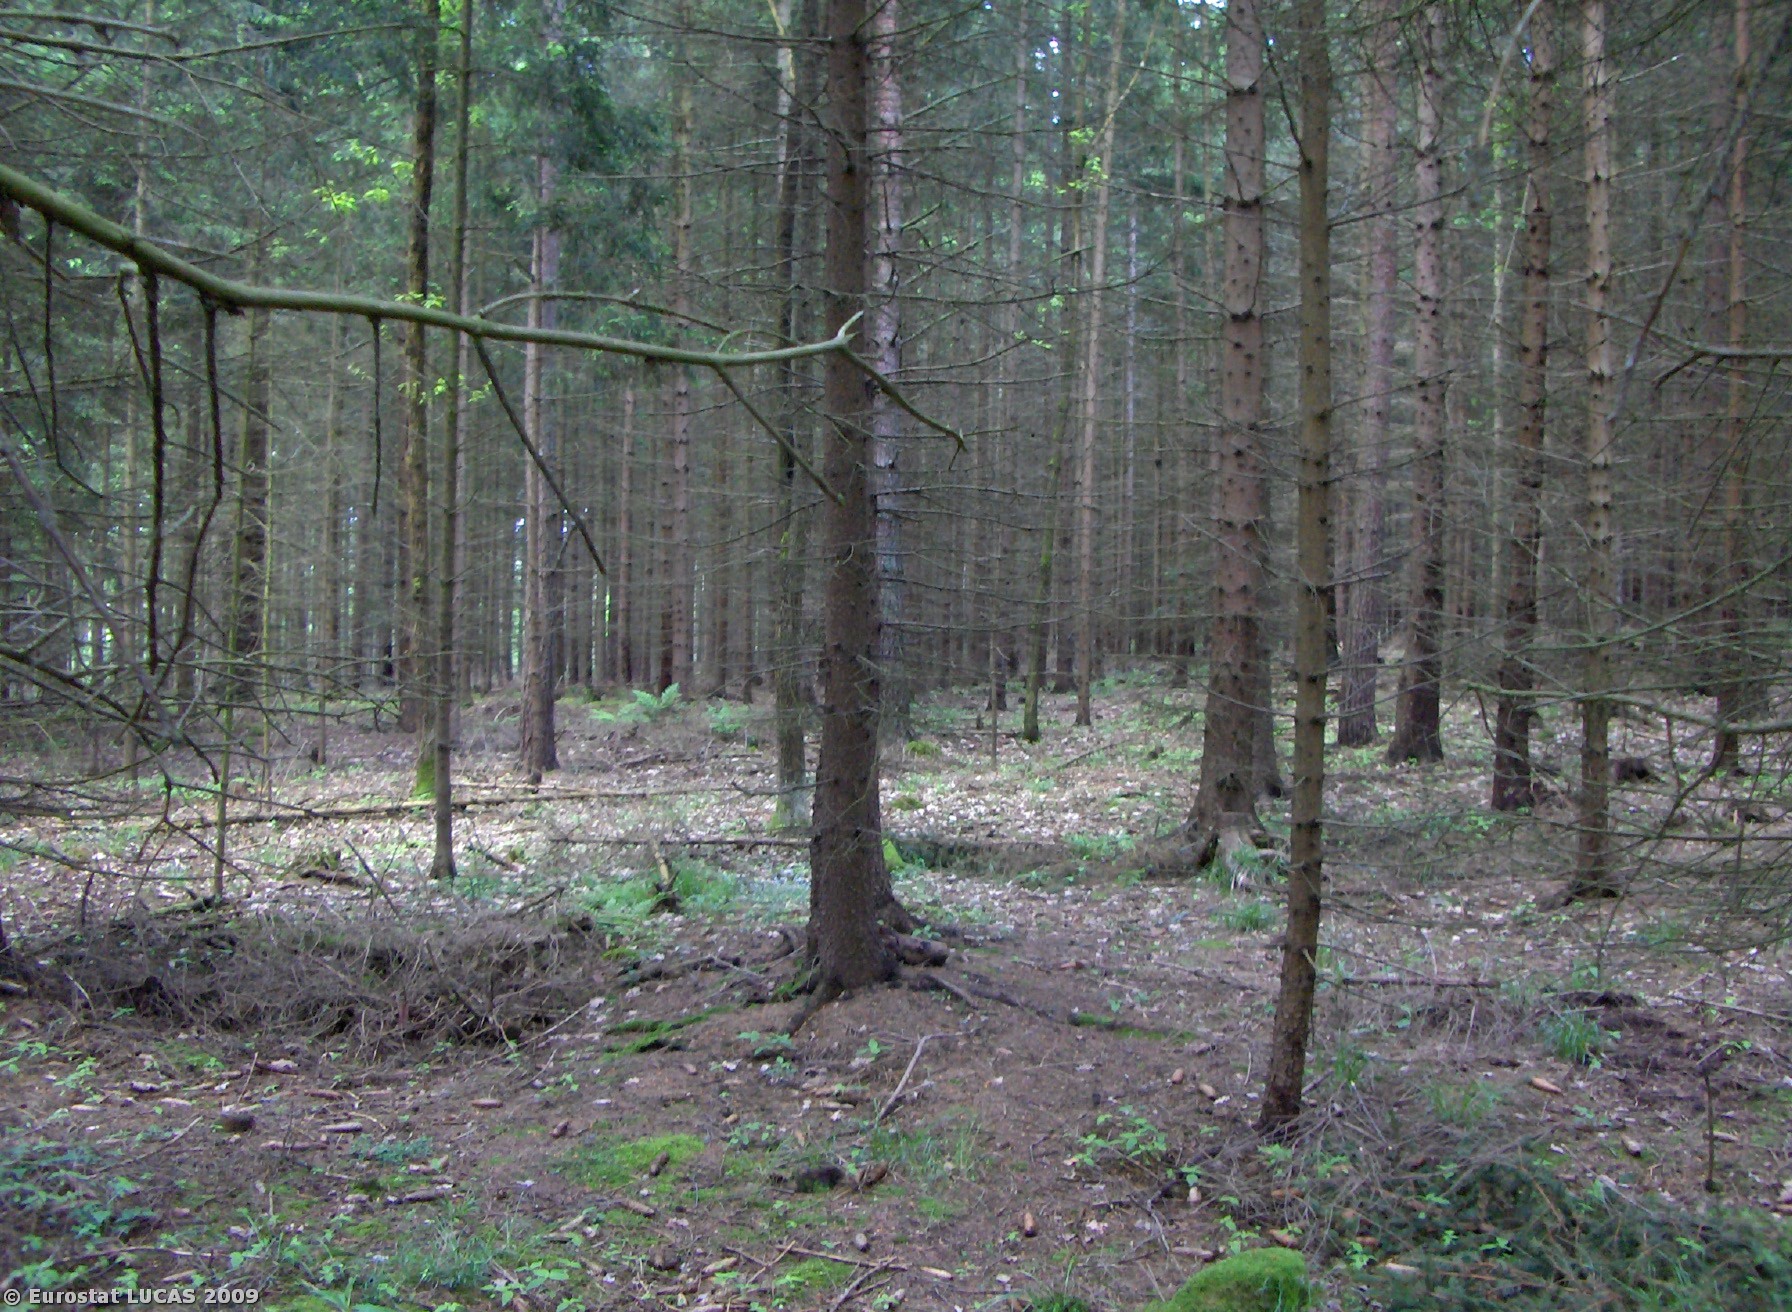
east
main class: Woodland
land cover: Coniferous woodland
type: hemiboreal forest and nemoral coniferous forest and mixed broadleaved-coniferous forest
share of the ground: > 75 %
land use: Forestry
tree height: > 5 m
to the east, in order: Coniferous woodland; Tracks; Coniferous woodland; Tracks; Coniferous woodland
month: May
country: CZ
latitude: 49.4762
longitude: 14.2104
